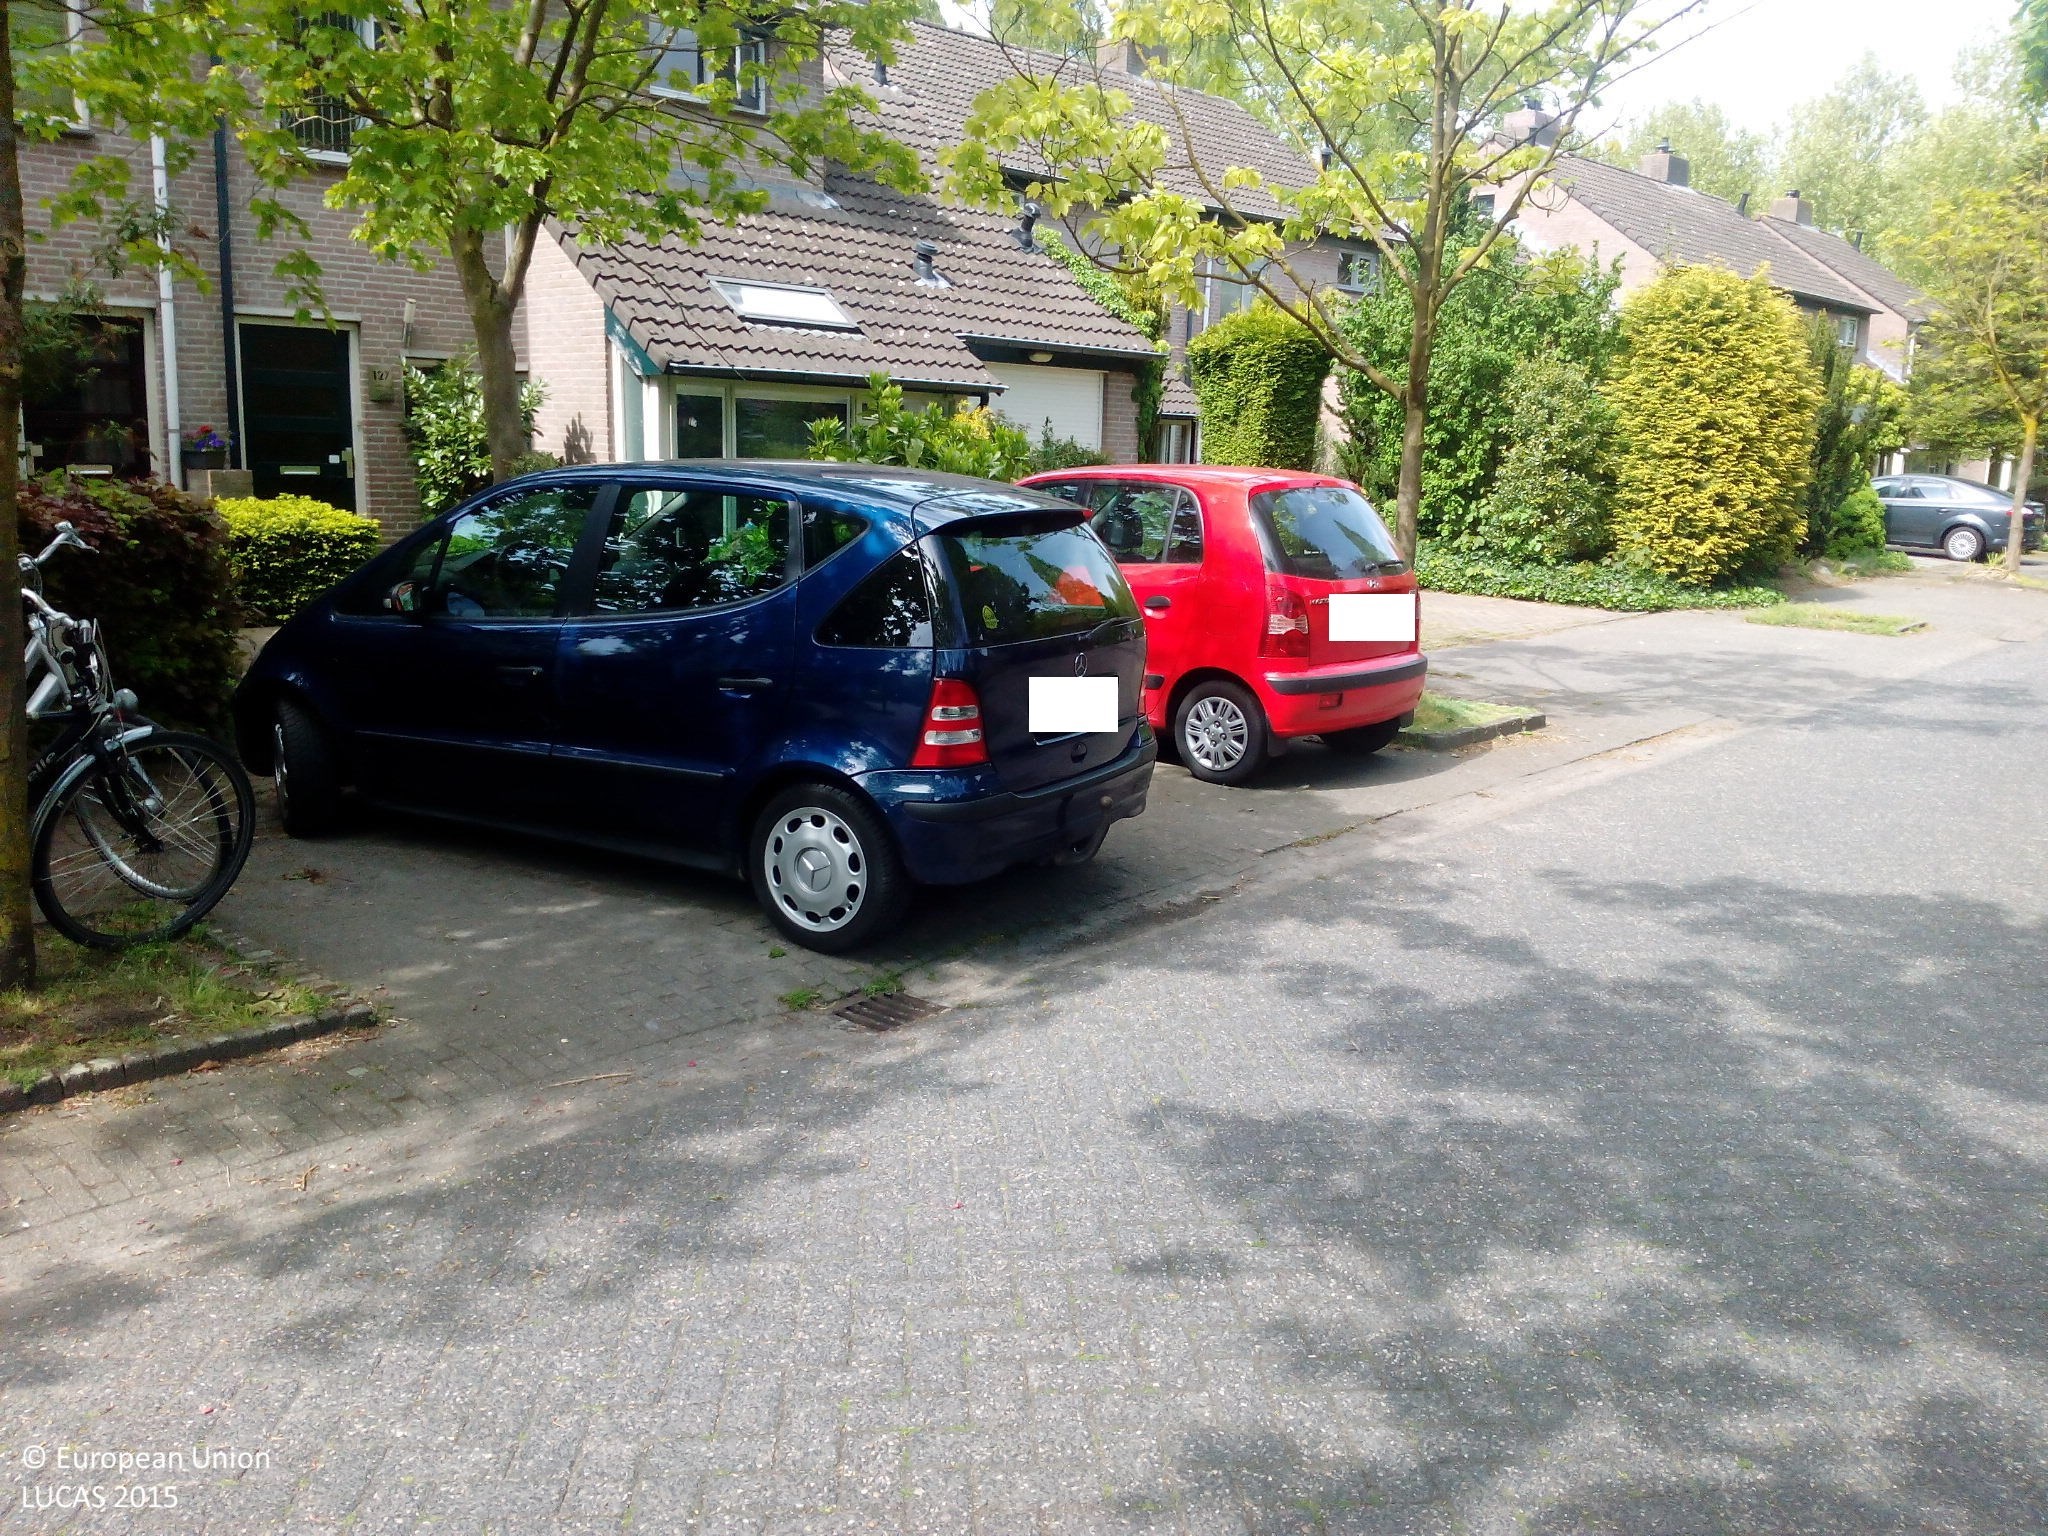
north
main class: Woodland
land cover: Broadleaved woodland
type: mesophytic deciduous forest
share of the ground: 50 - 75 %
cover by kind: broadleaved forest trees 50 %, consolidated bare surface 50 %
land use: Residential
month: May
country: NL
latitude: 51.5187
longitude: 5.5163
